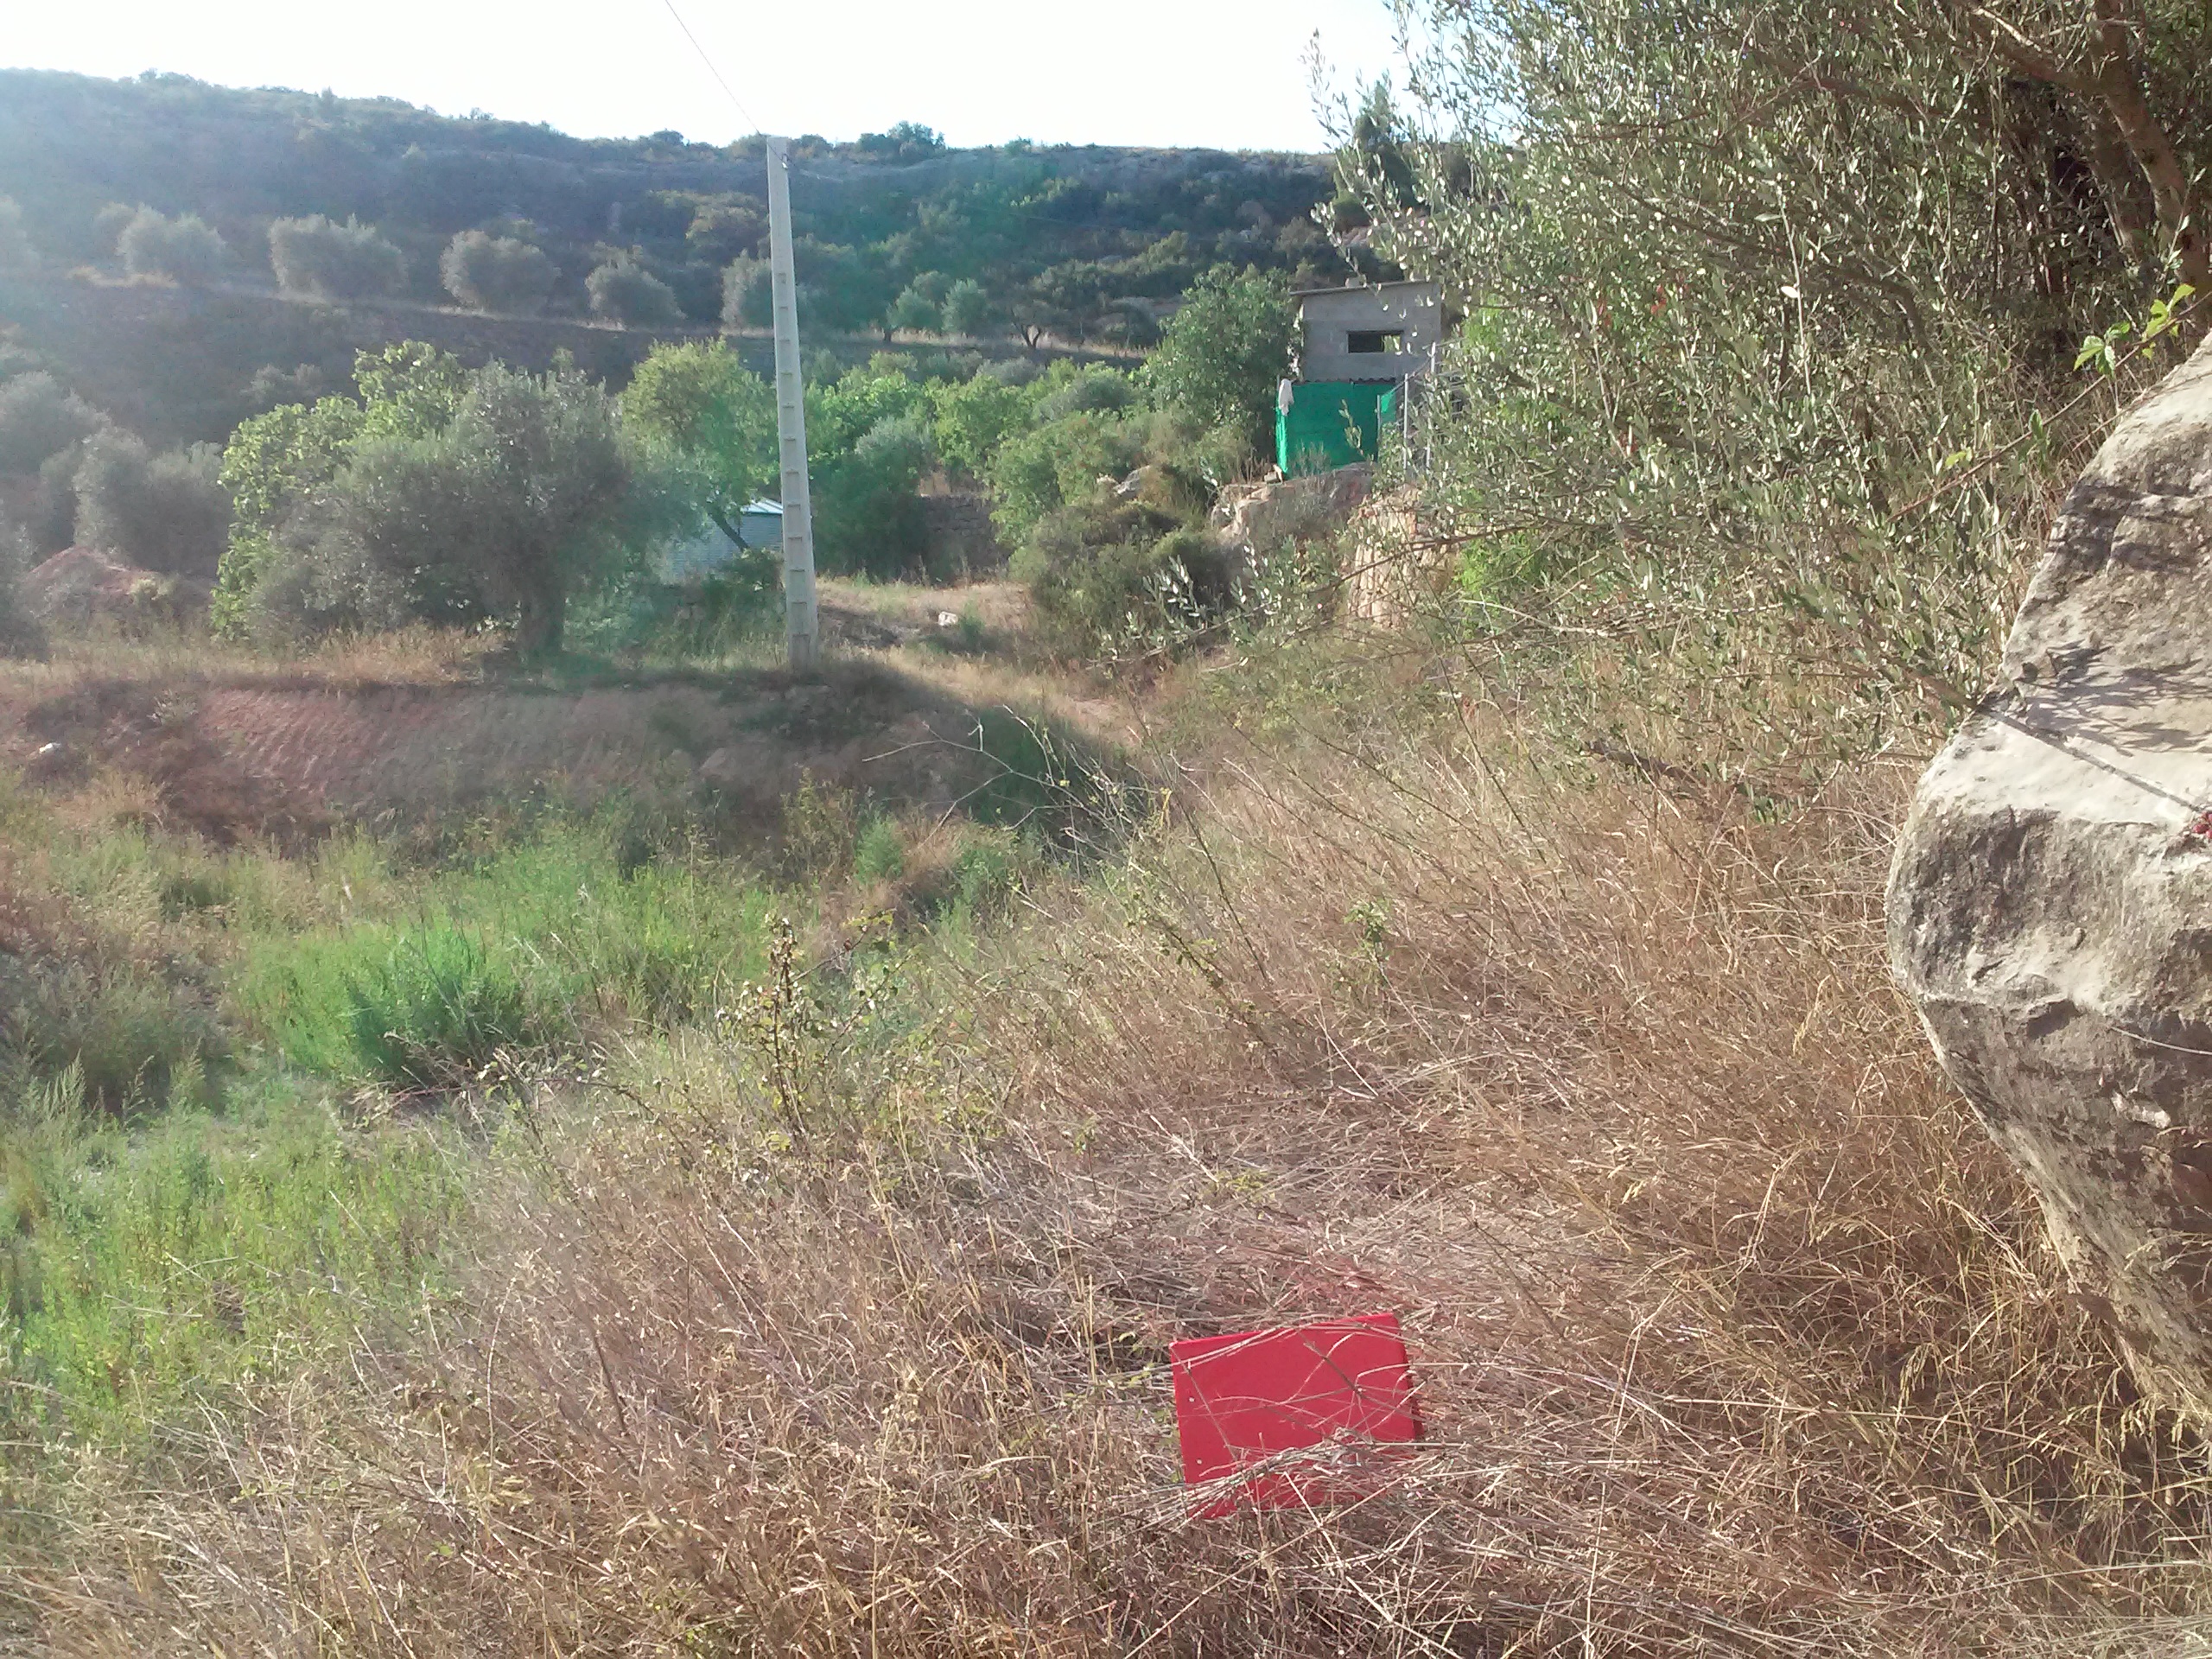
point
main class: Shrubland
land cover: Shrubland with sparse tree cover
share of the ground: > 75 %
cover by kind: shrubs 55 %, herbaceous plants 30 %, consolidated bare surface 10 %, broadleaved forest trees 5 %
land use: Semi-natural and natural areas not in use
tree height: < 5 m
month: August
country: ES
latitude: 41.3778
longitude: 0.7713
